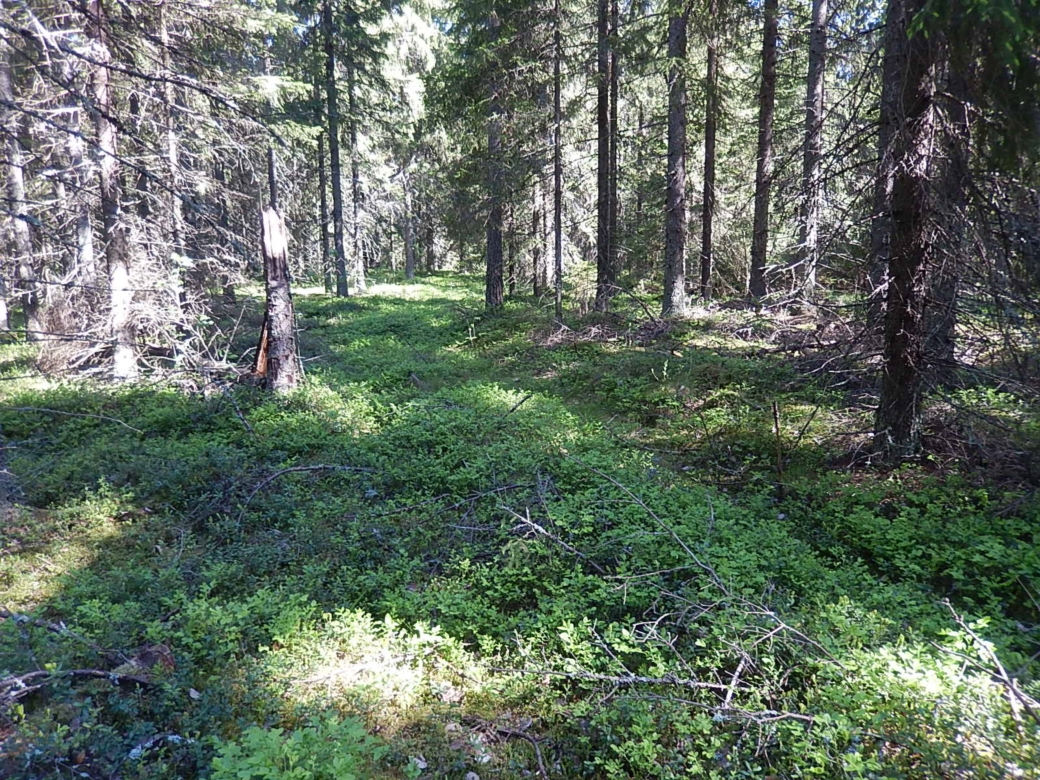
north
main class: Woodland
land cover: Spruce dominated coniferous woodland
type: boreal forest
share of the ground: > 75 %
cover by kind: coniferous forest trees 85 %, shrubs 15 %
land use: Forestry
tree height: > 5 m
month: June
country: FI
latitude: 62.0396
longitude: 21.5374
